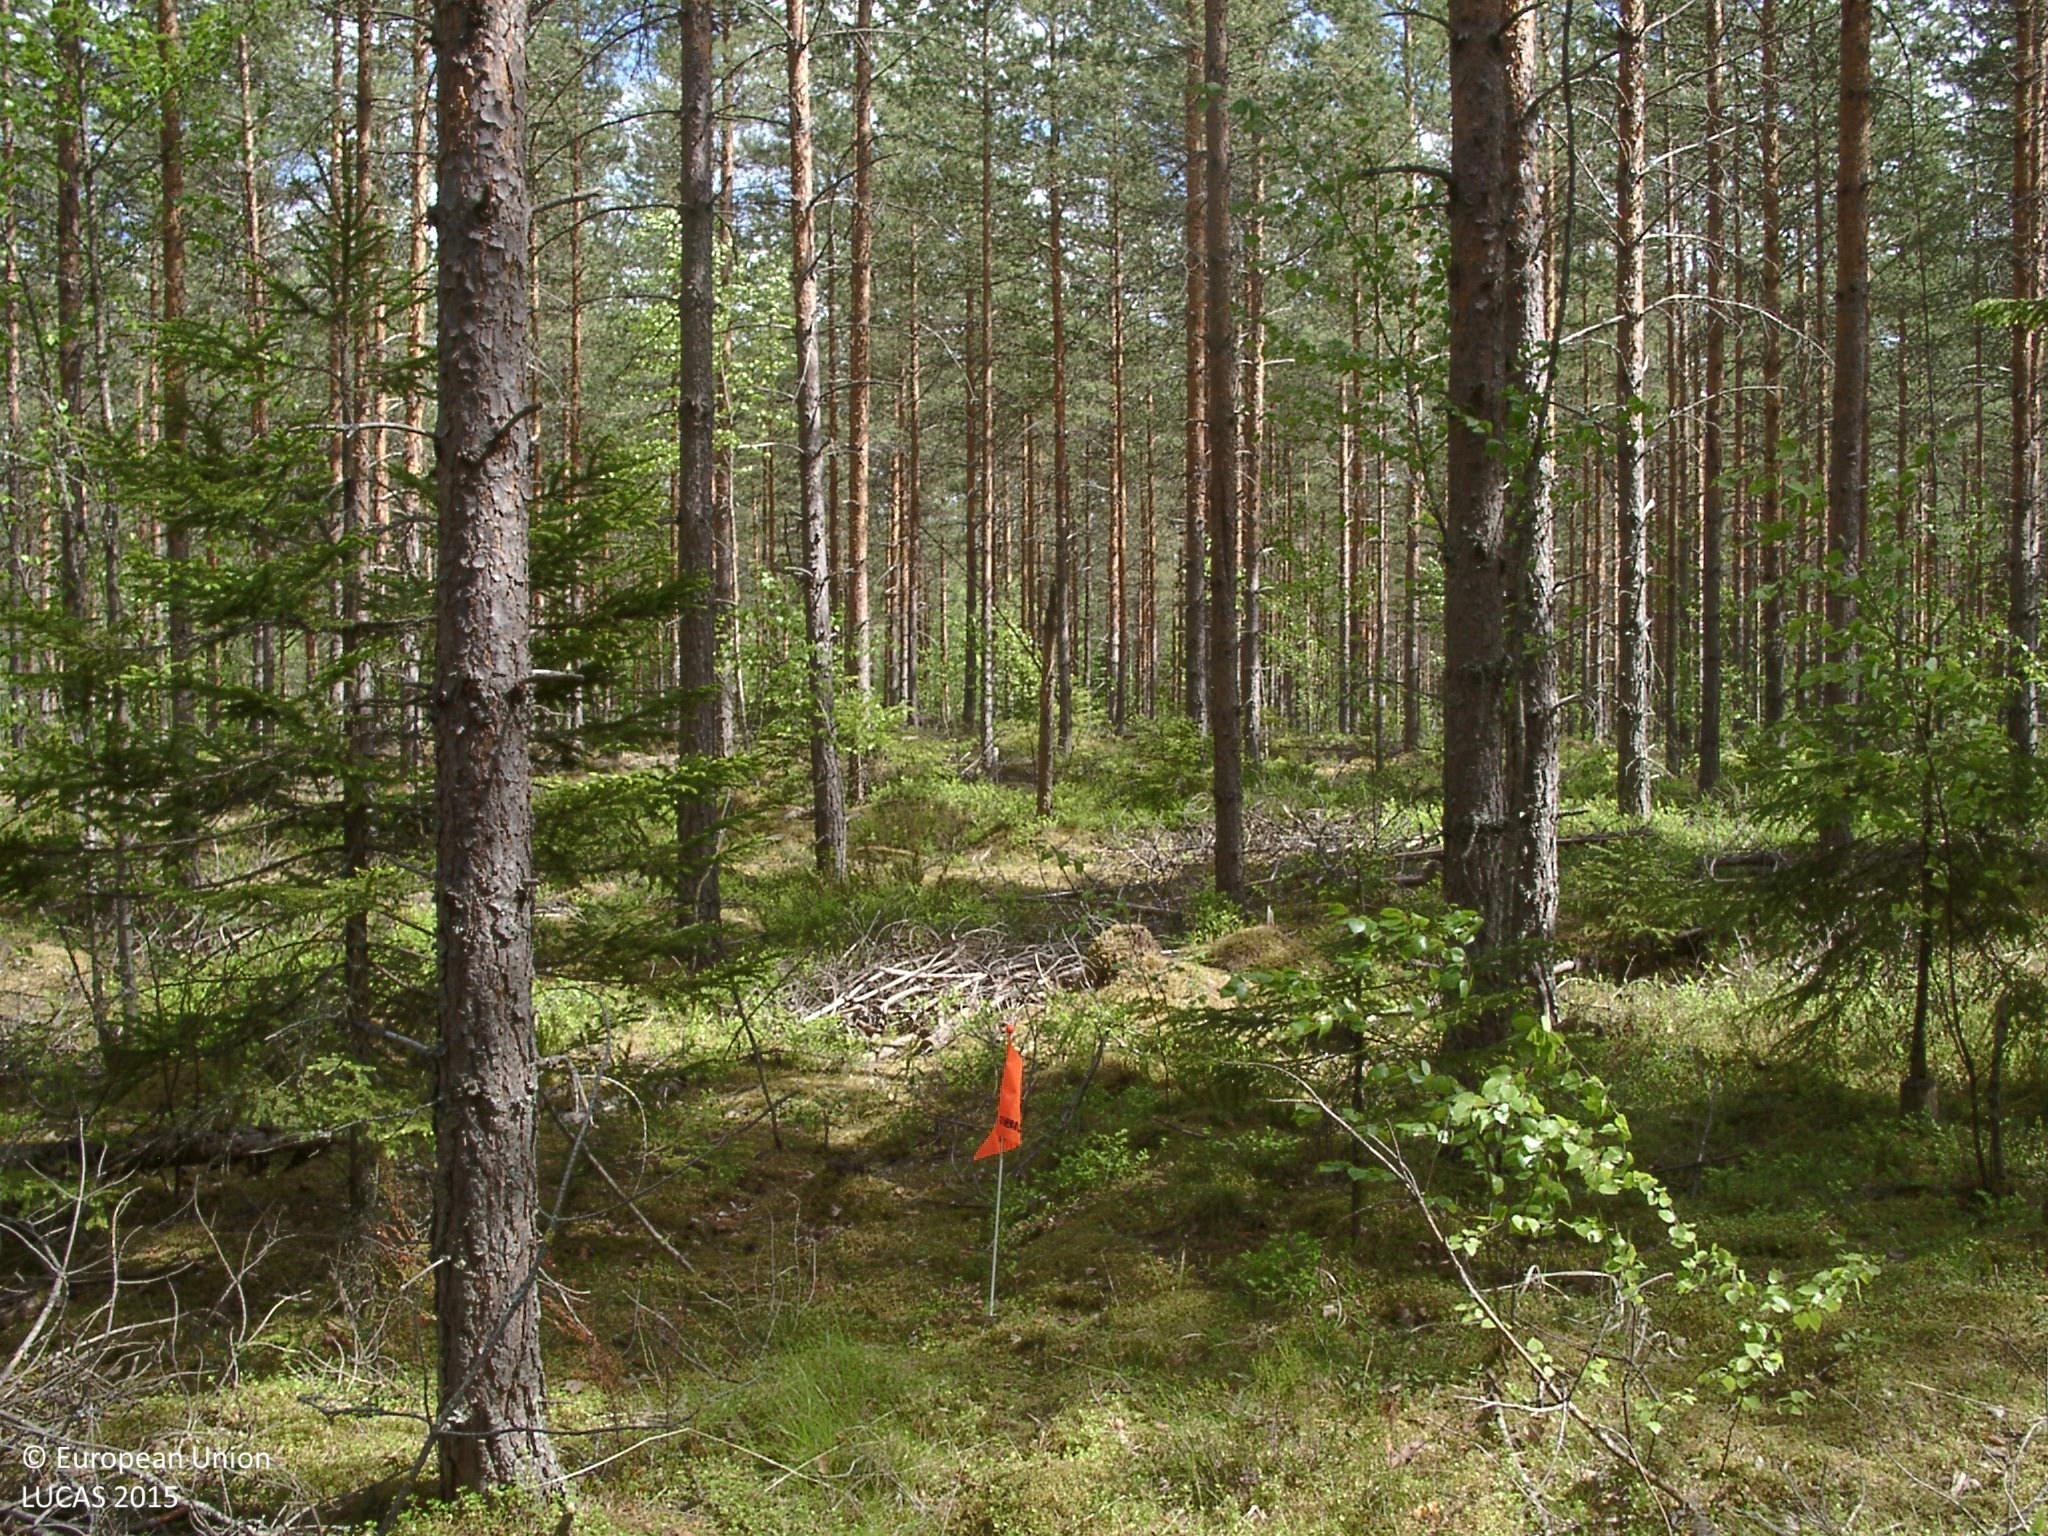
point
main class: Woodland
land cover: Pine dominated coniferous woodland
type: boreal forest
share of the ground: 50 - 75 %
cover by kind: coniferous forest trees 60 %, lichens and mosses 20 %, shrubs 15 %, broadleaved forest trees 5 %
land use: Forestry
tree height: > 5 m
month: June
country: FI
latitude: 62.2338
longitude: 26.1195
